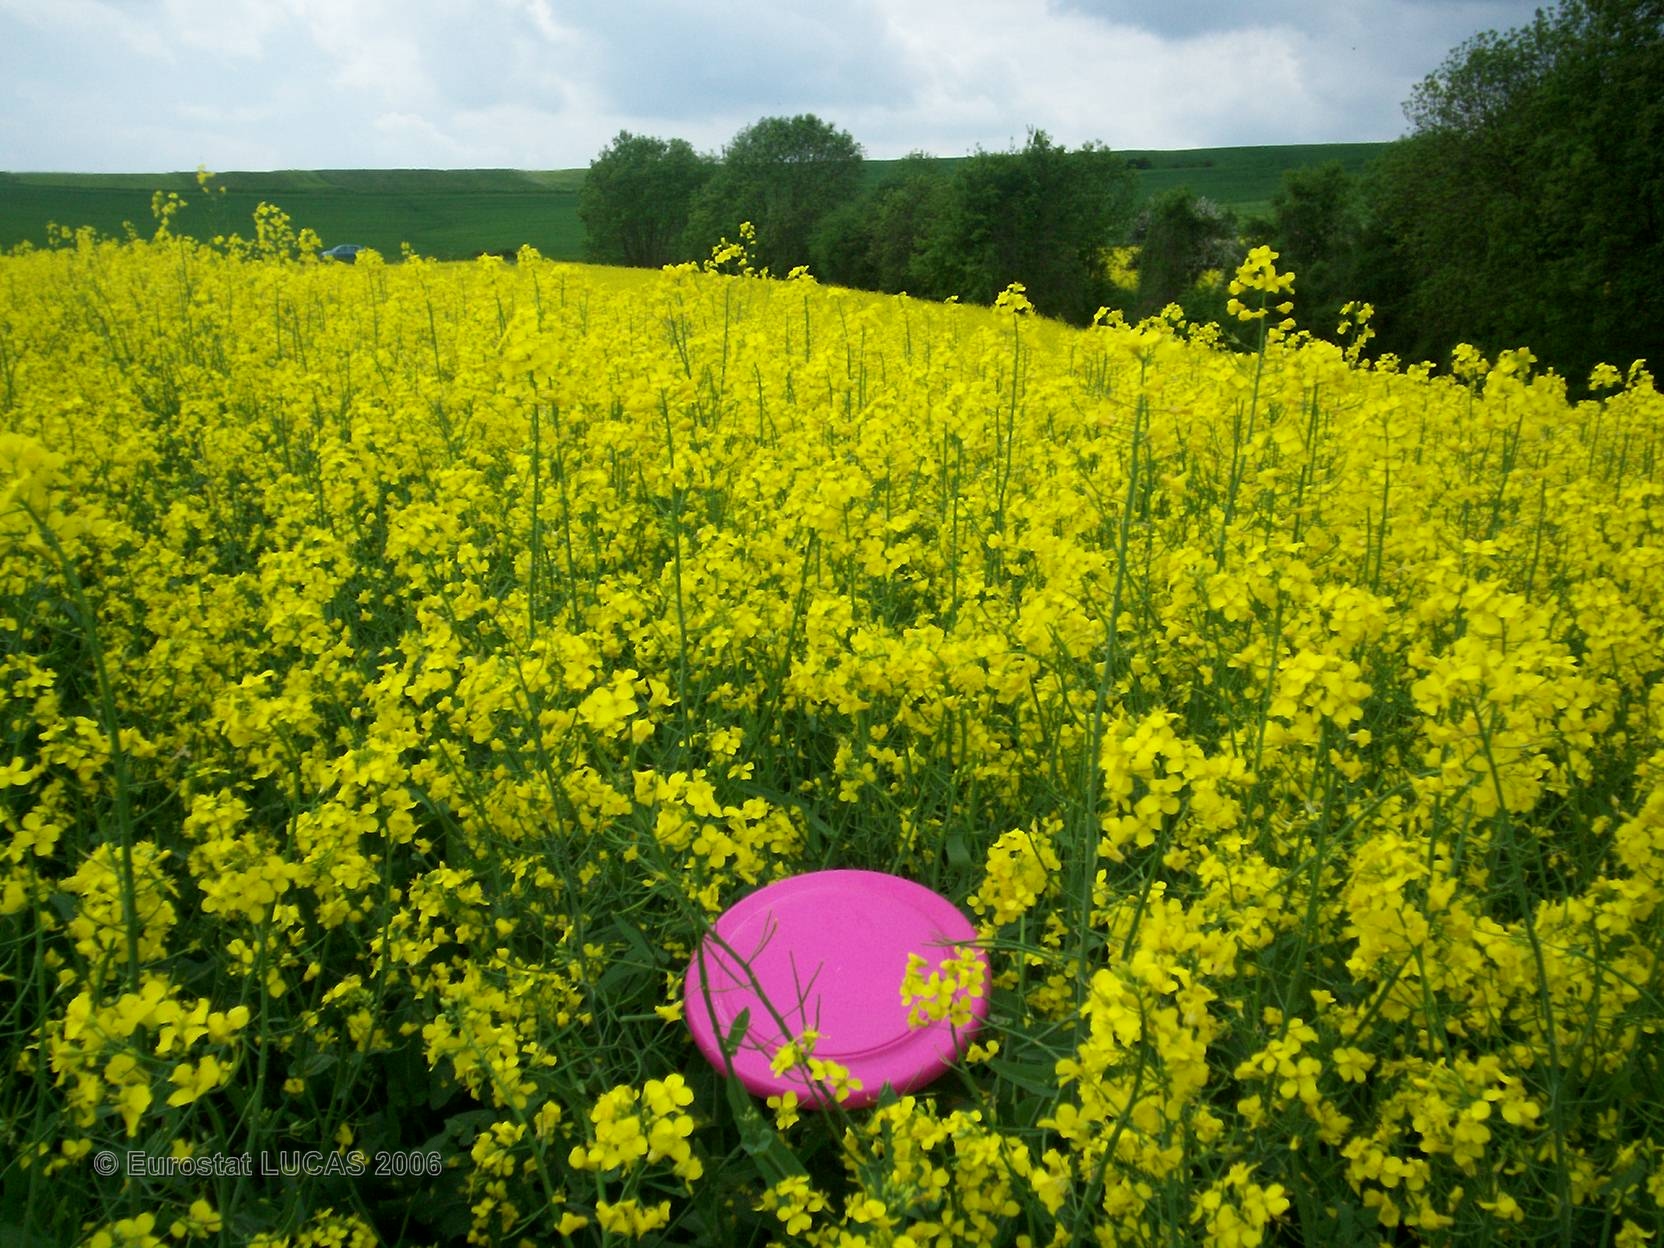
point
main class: Cropland
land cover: Rape and turnip rape
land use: Agriculture (excluding fallow land and kitchen gardens)
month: May
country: FR
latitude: 49.4074
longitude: 6.4027
